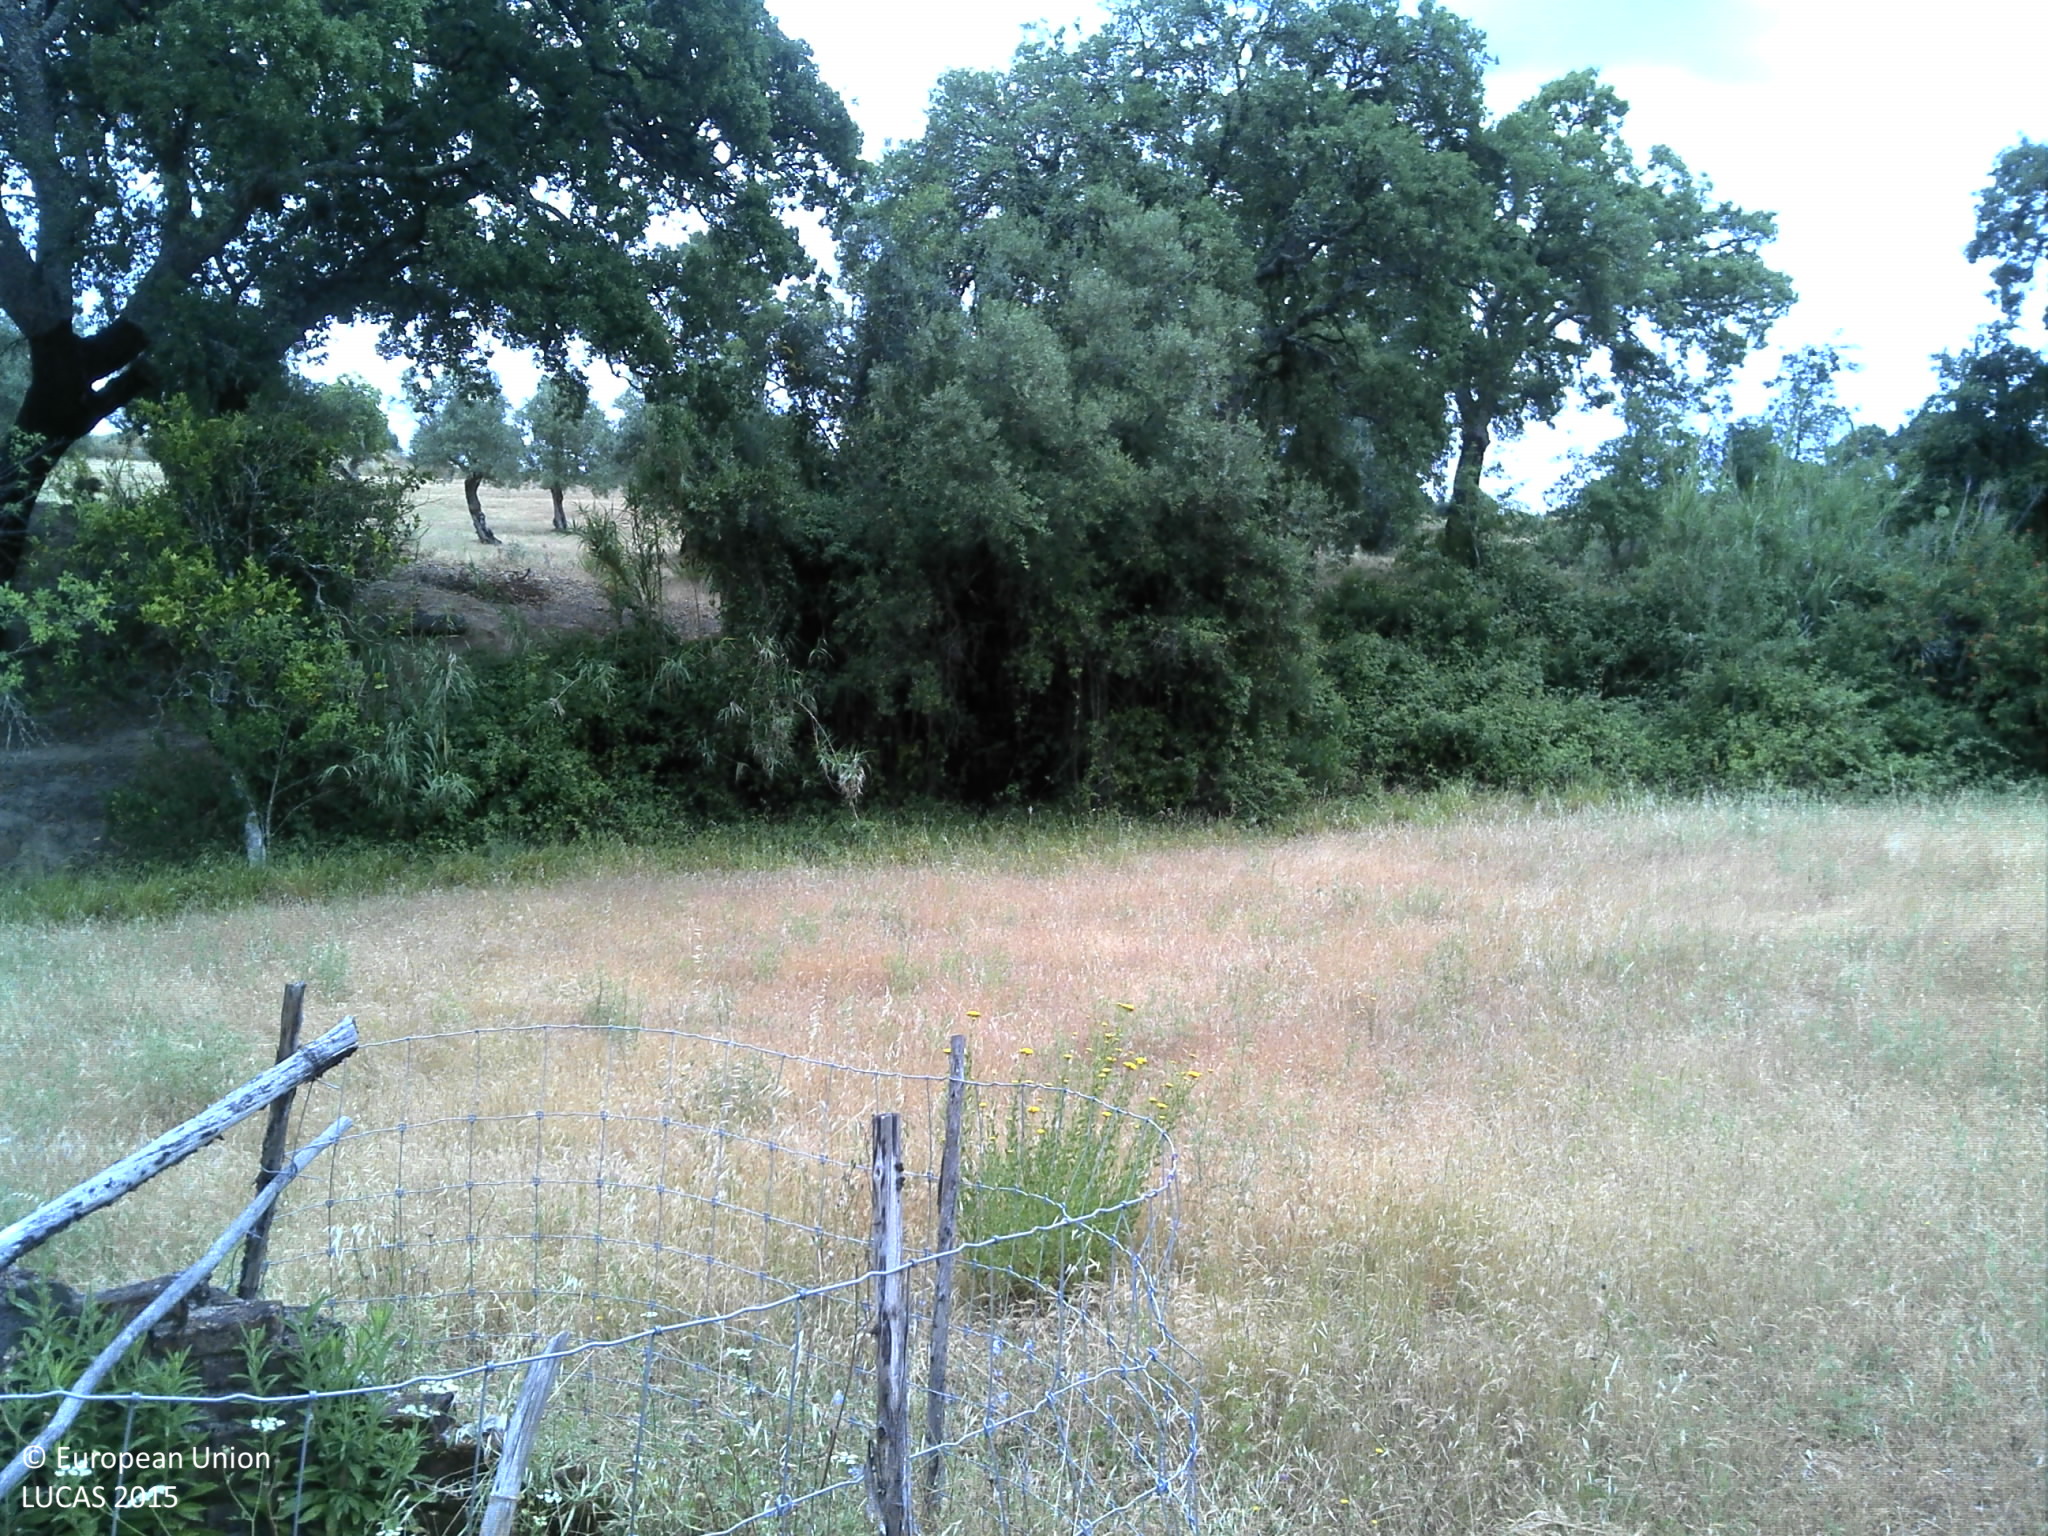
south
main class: Cropland
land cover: Olive groves
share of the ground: 10 - 25 %
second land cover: Grassland without tree/shrub cover
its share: 50 - 75 %
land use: Agriculture (excluding fallow land and kitchen gardens)
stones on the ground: < 10 %
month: June
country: PT
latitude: 39.4321
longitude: -8.7956
